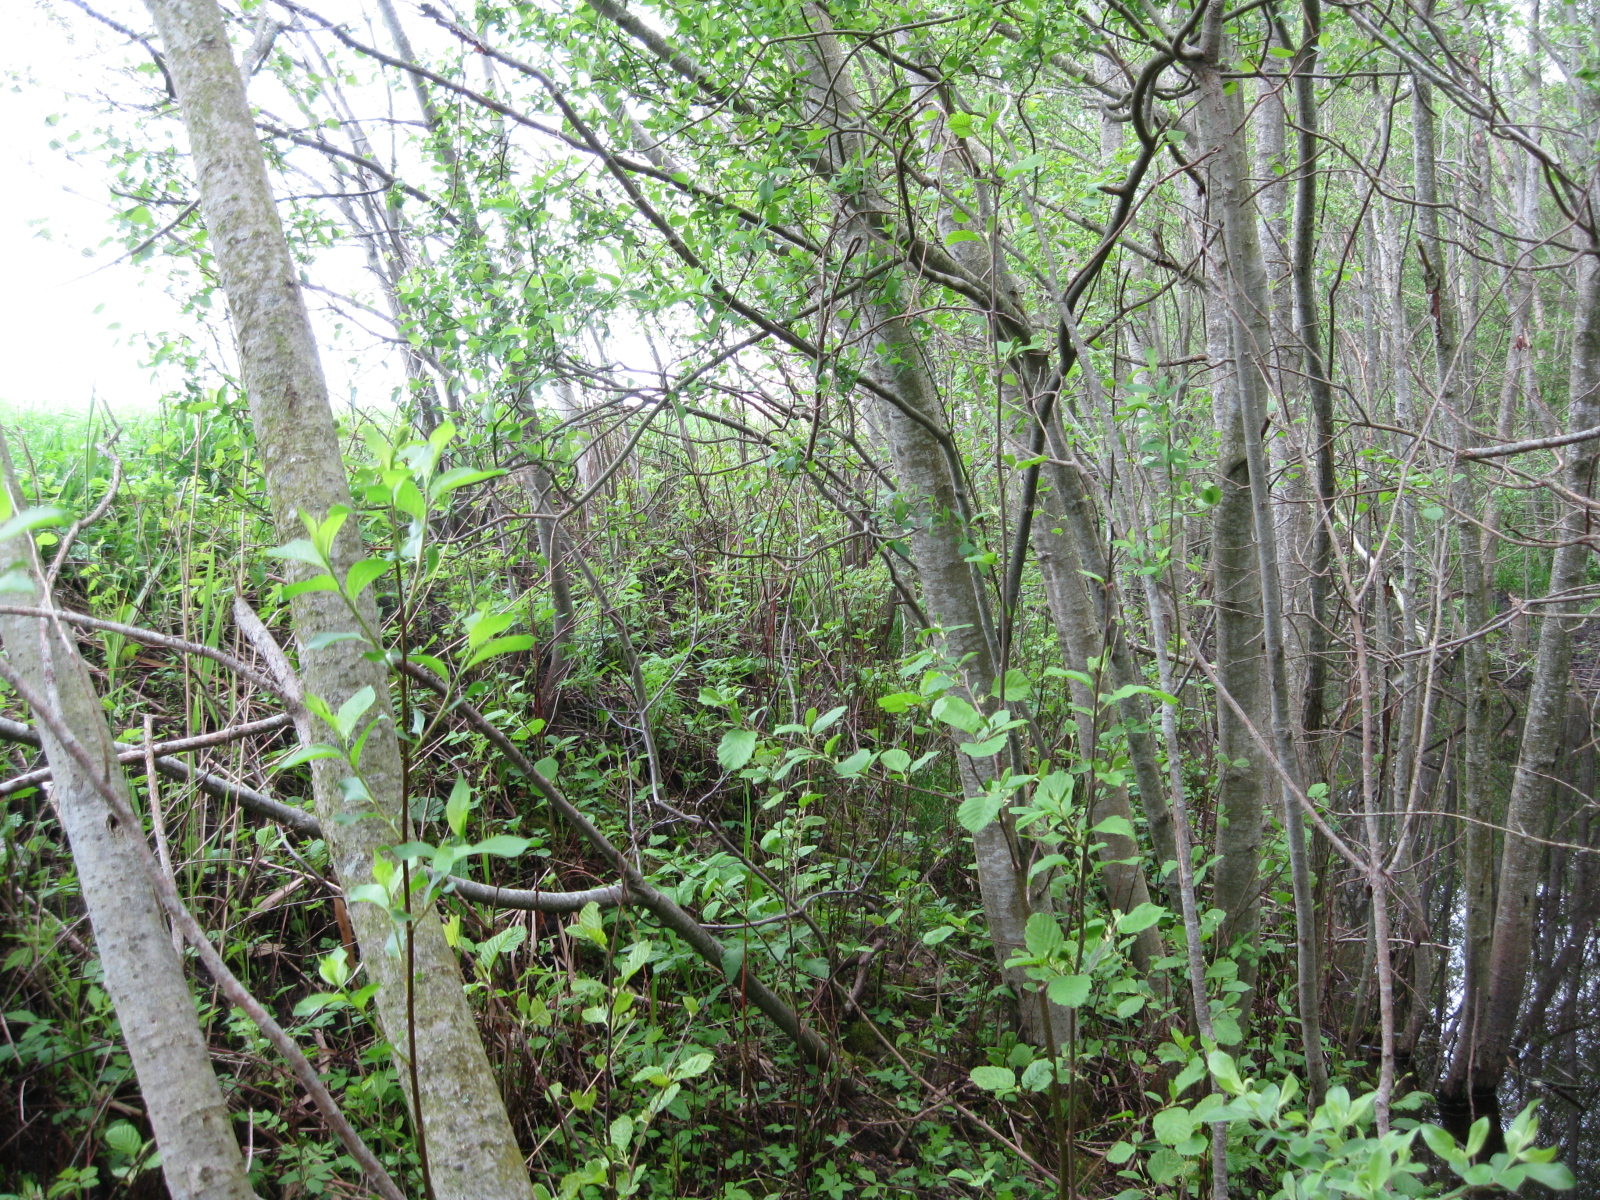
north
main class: Woodland
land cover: Broadleaved woodland
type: non-riverine alder, birch or aspen forest
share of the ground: > 75 %
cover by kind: broadleaved forest trees 85 %, shrubs 5 %, herbaceous plants 5 %, unconsolidated bare surface 5 %
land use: Forestry
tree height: > 5 m
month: May
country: LT
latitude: 56.2012
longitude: 23.8322
